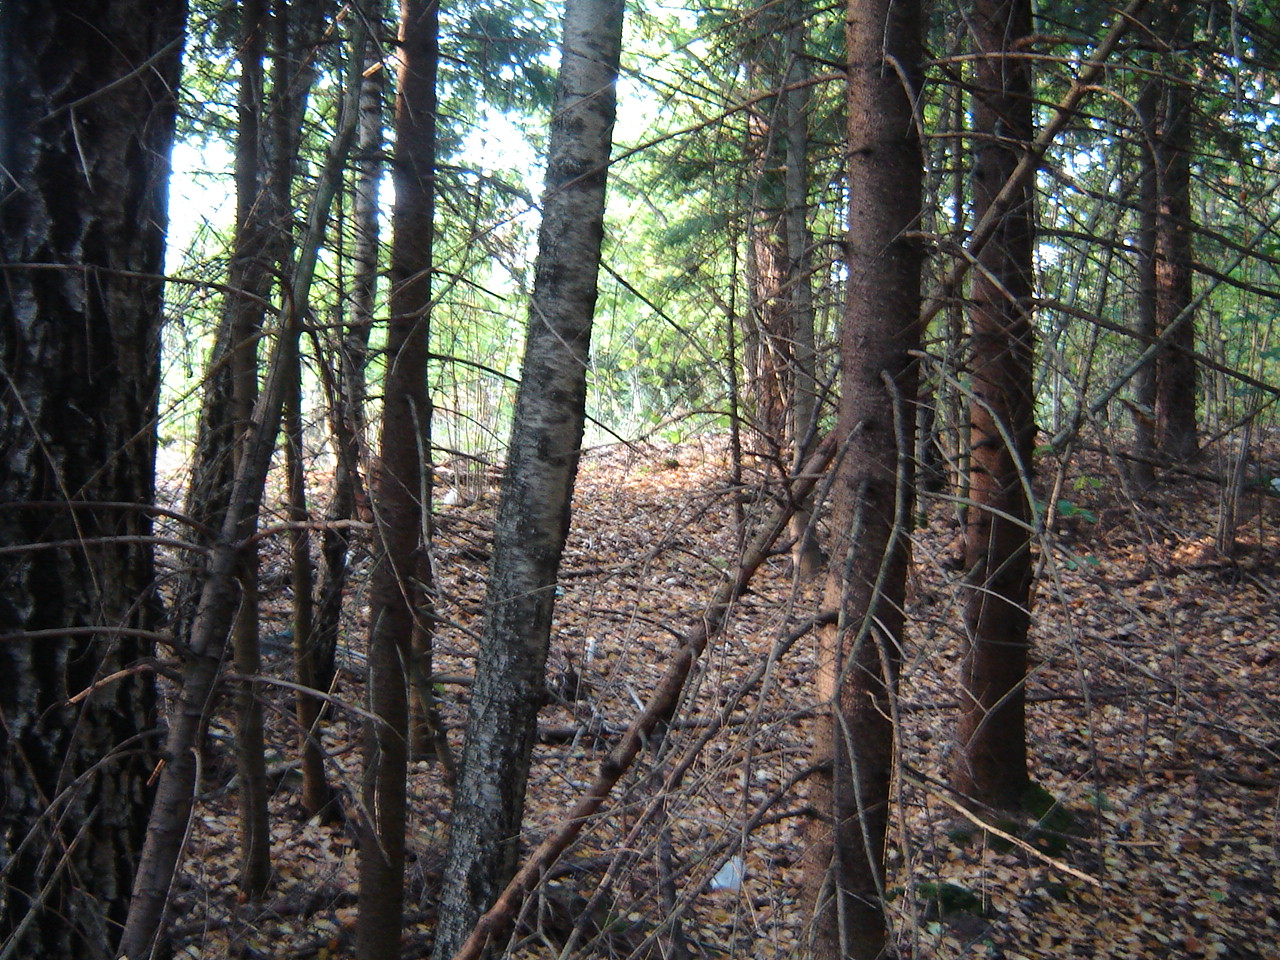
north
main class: Woodland
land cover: Pine dominated mixed woodland
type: hemiboreal forest and nemoral coniferous forest and mixed broadleaved-coniferous forest
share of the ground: > 75 %
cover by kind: coniferous forest trees 70 %, broadleaved forest trees 25 %, unconsolidated bare surface 5 %
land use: Forestry
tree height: > 5 m
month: August
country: LT
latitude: 54.7161
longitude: 24.9695
